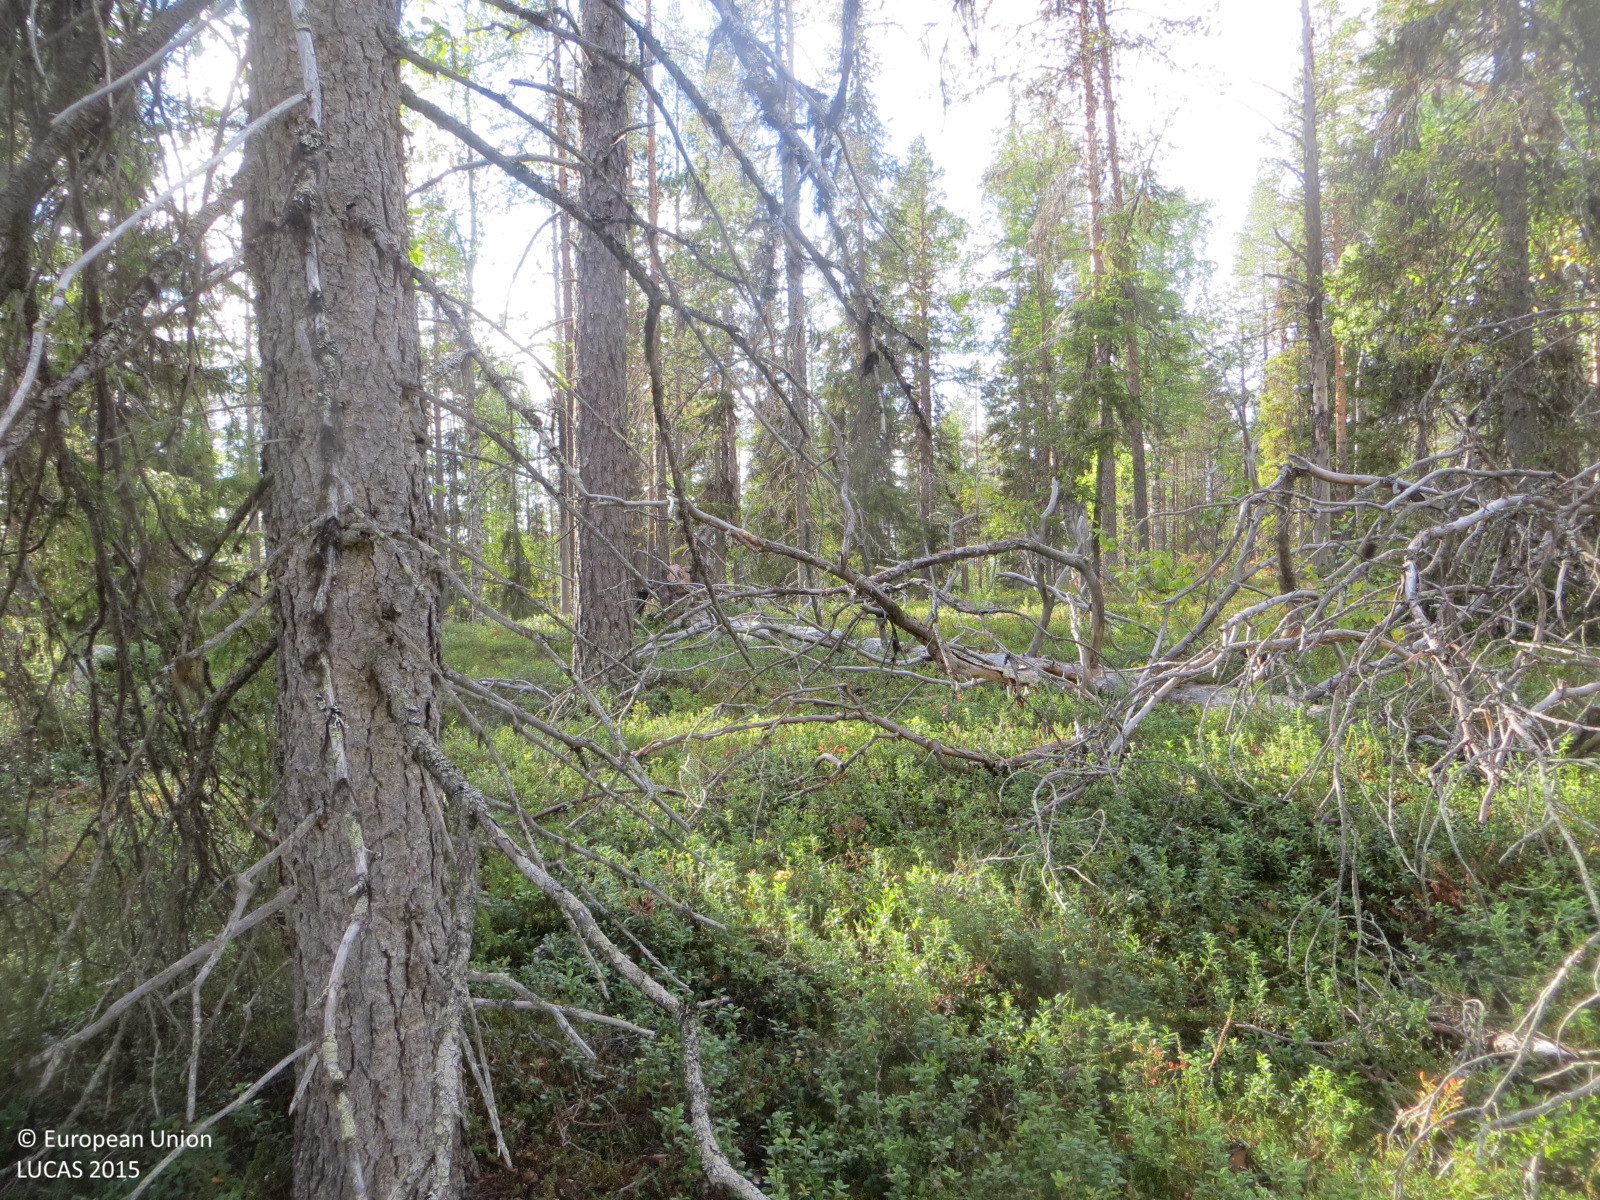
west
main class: Woodland
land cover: Other coniferous woodland
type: boreal forest
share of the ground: 50 - 75 %
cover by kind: coniferous forest trees 50 %, shrubs 50 %
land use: Semi-natural and natural areas not in use
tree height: > 5 m
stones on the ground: < 10 %
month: September
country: FI
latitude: 67.9583
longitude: 24.0332
